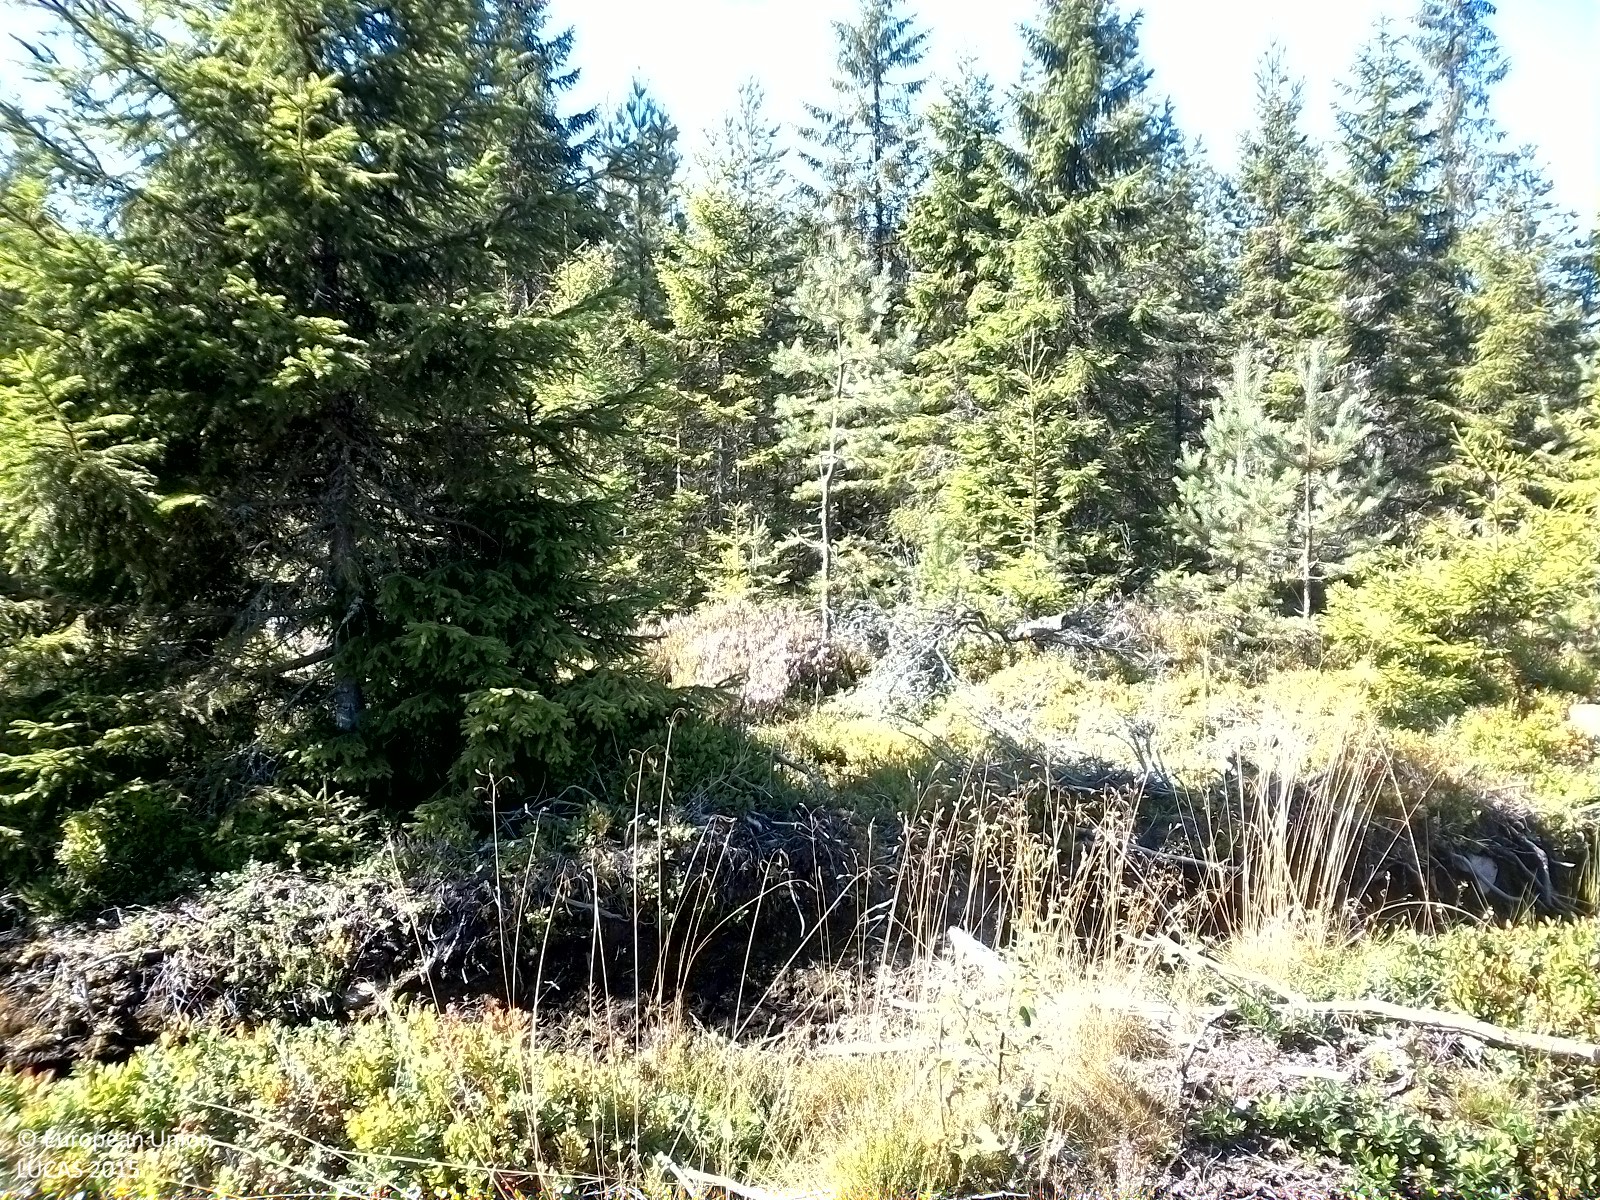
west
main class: Woodland
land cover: Pine dominated coniferous woodland
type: boreal forest
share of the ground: 10 - 25 %
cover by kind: shrubs 45 %, herbaceous plants 25 %, coniferous forest trees 15 %, lichens and mosses 15 %
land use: Forestry
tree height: > 5 m
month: August
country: SE
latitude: 59.4173
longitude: 14.6960
